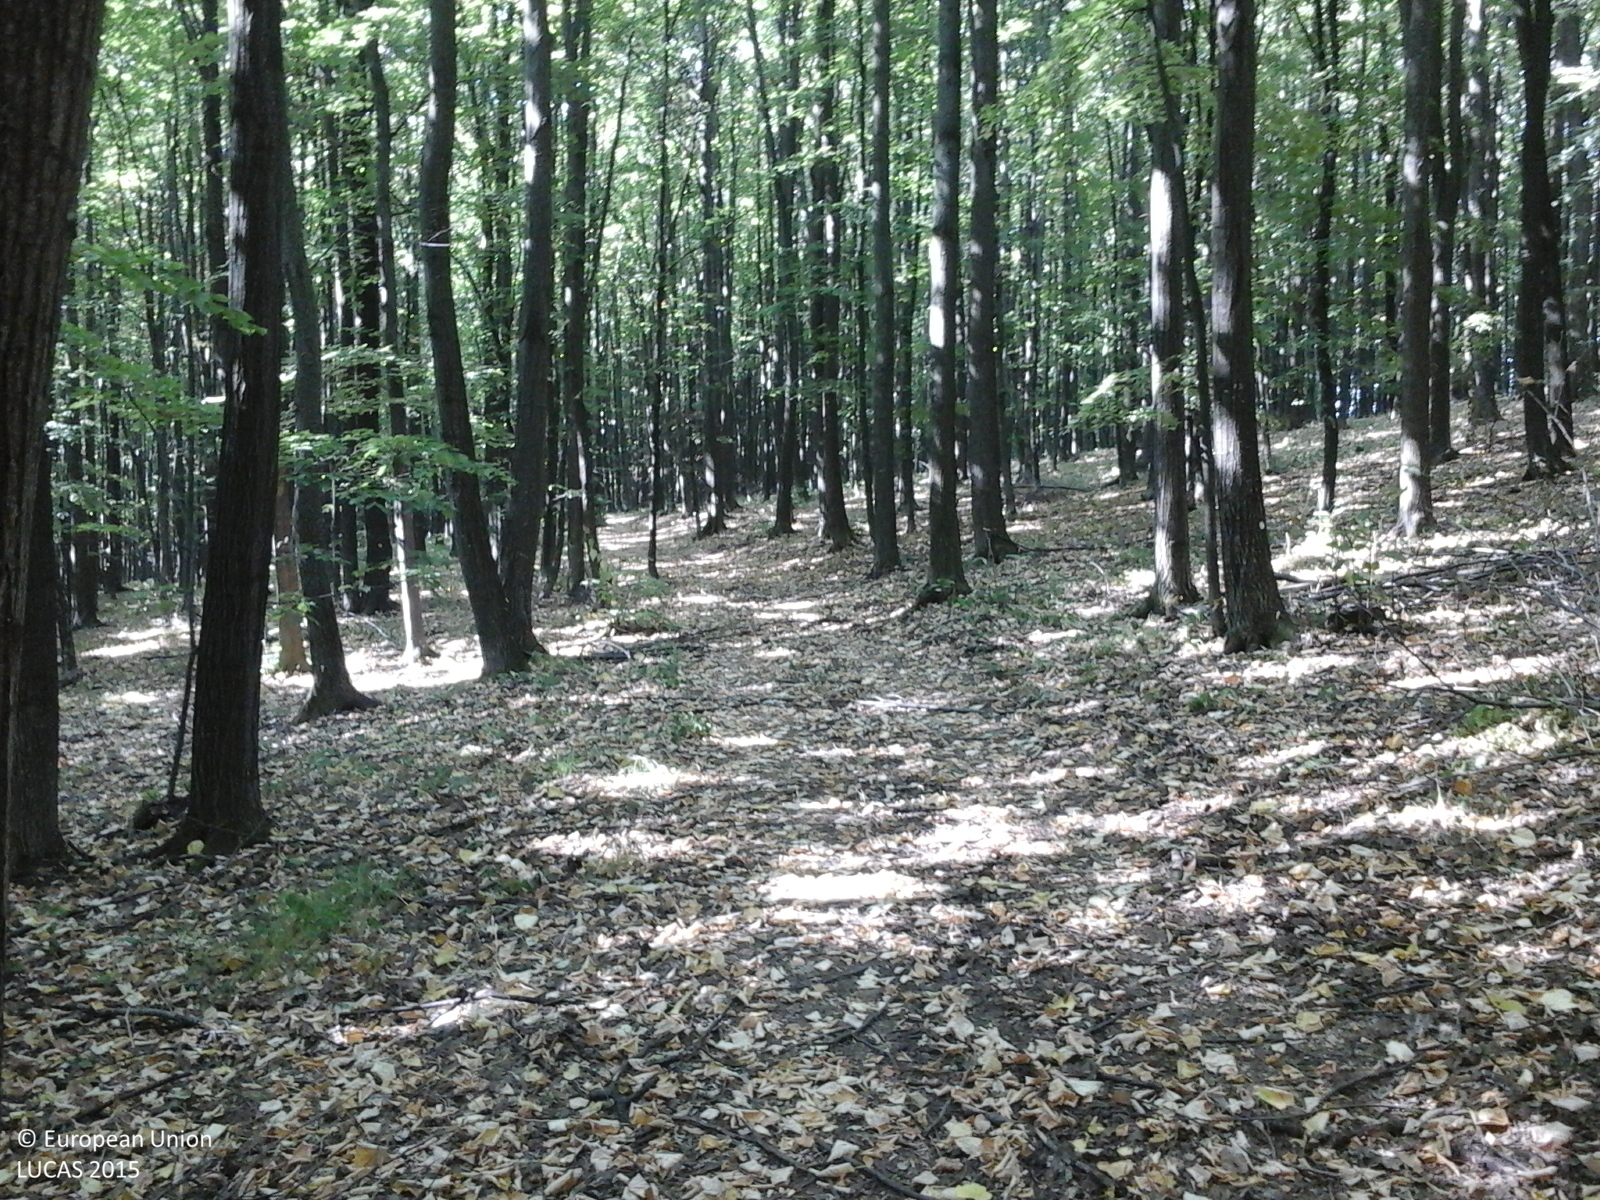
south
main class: Woodland
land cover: Broadleaved woodland
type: thermophilous deciduous forest
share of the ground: > 75 %
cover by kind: broadleaved forest trees 100 %
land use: Forestry
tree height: > 5 m
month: July
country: RO
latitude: 46.4505
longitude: 27.3286
